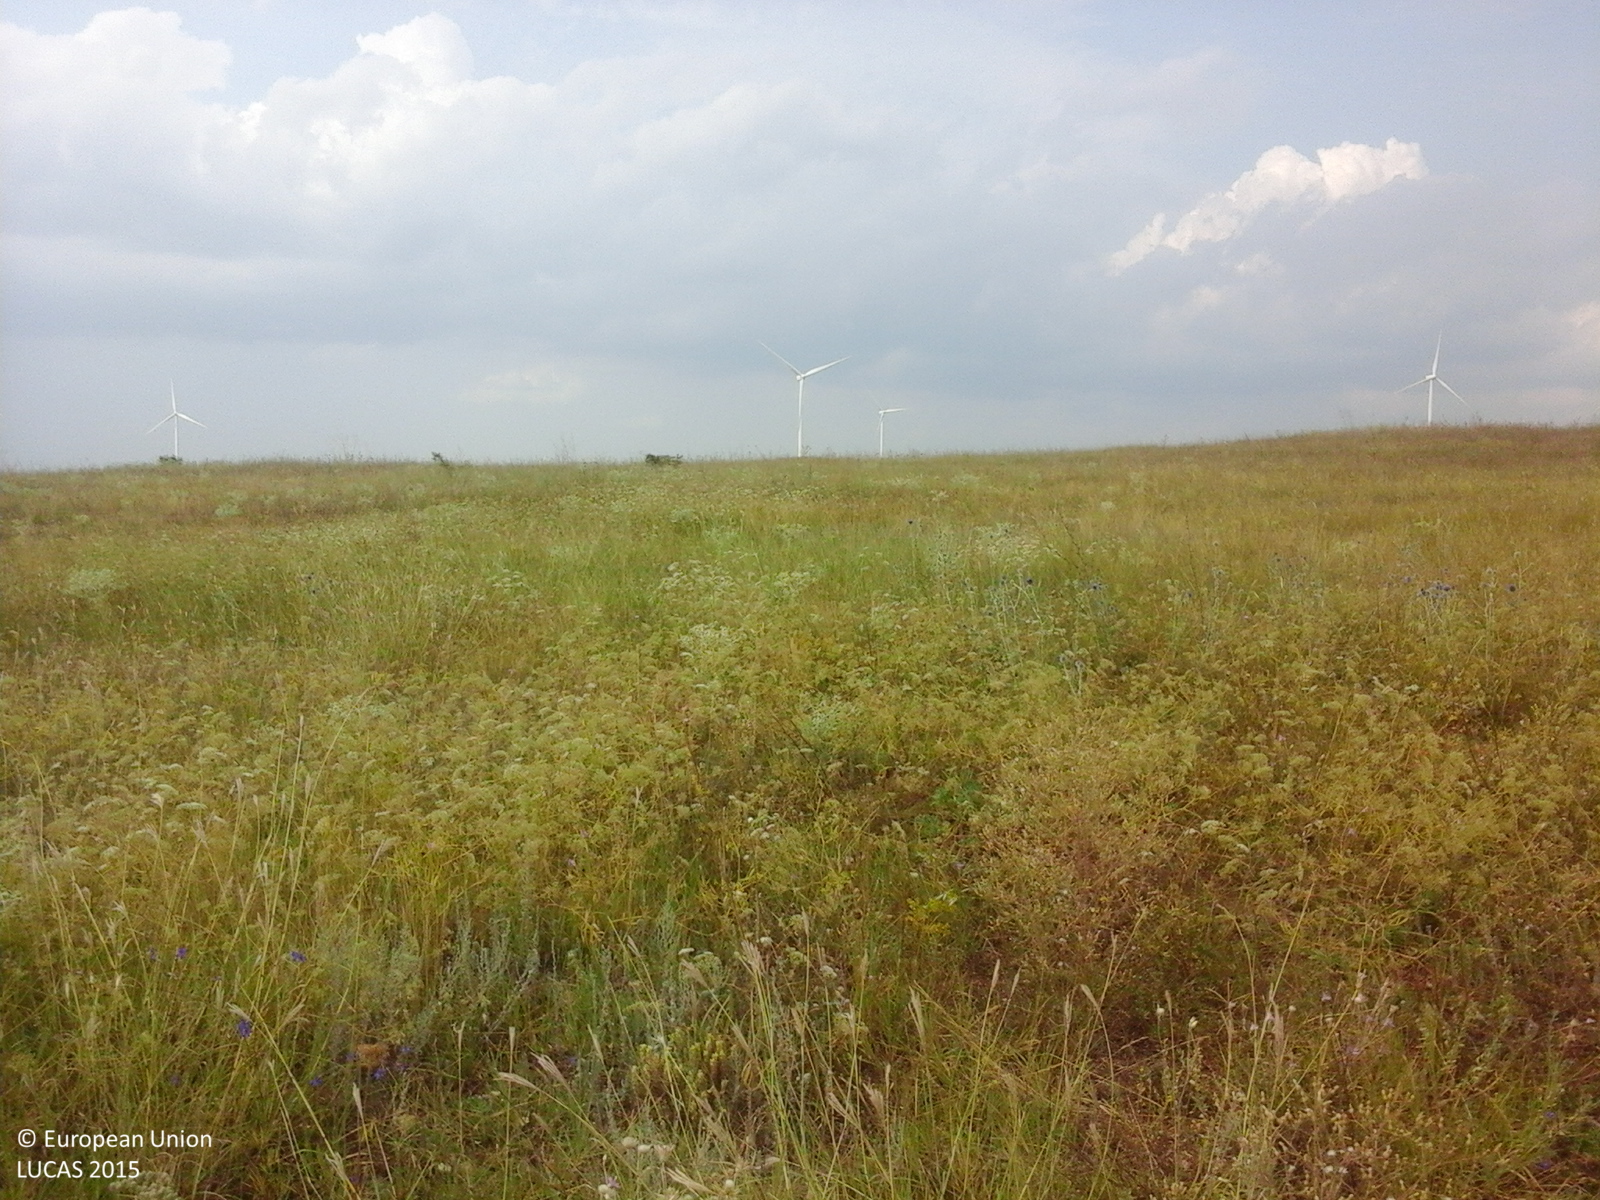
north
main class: Grassland
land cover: Spontaneously vegetated surfaces
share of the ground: 50 - 75 %
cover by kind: herbaceous plants 100 %
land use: Fallow land
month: July
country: RO
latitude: 45.0101
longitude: 28.8297
